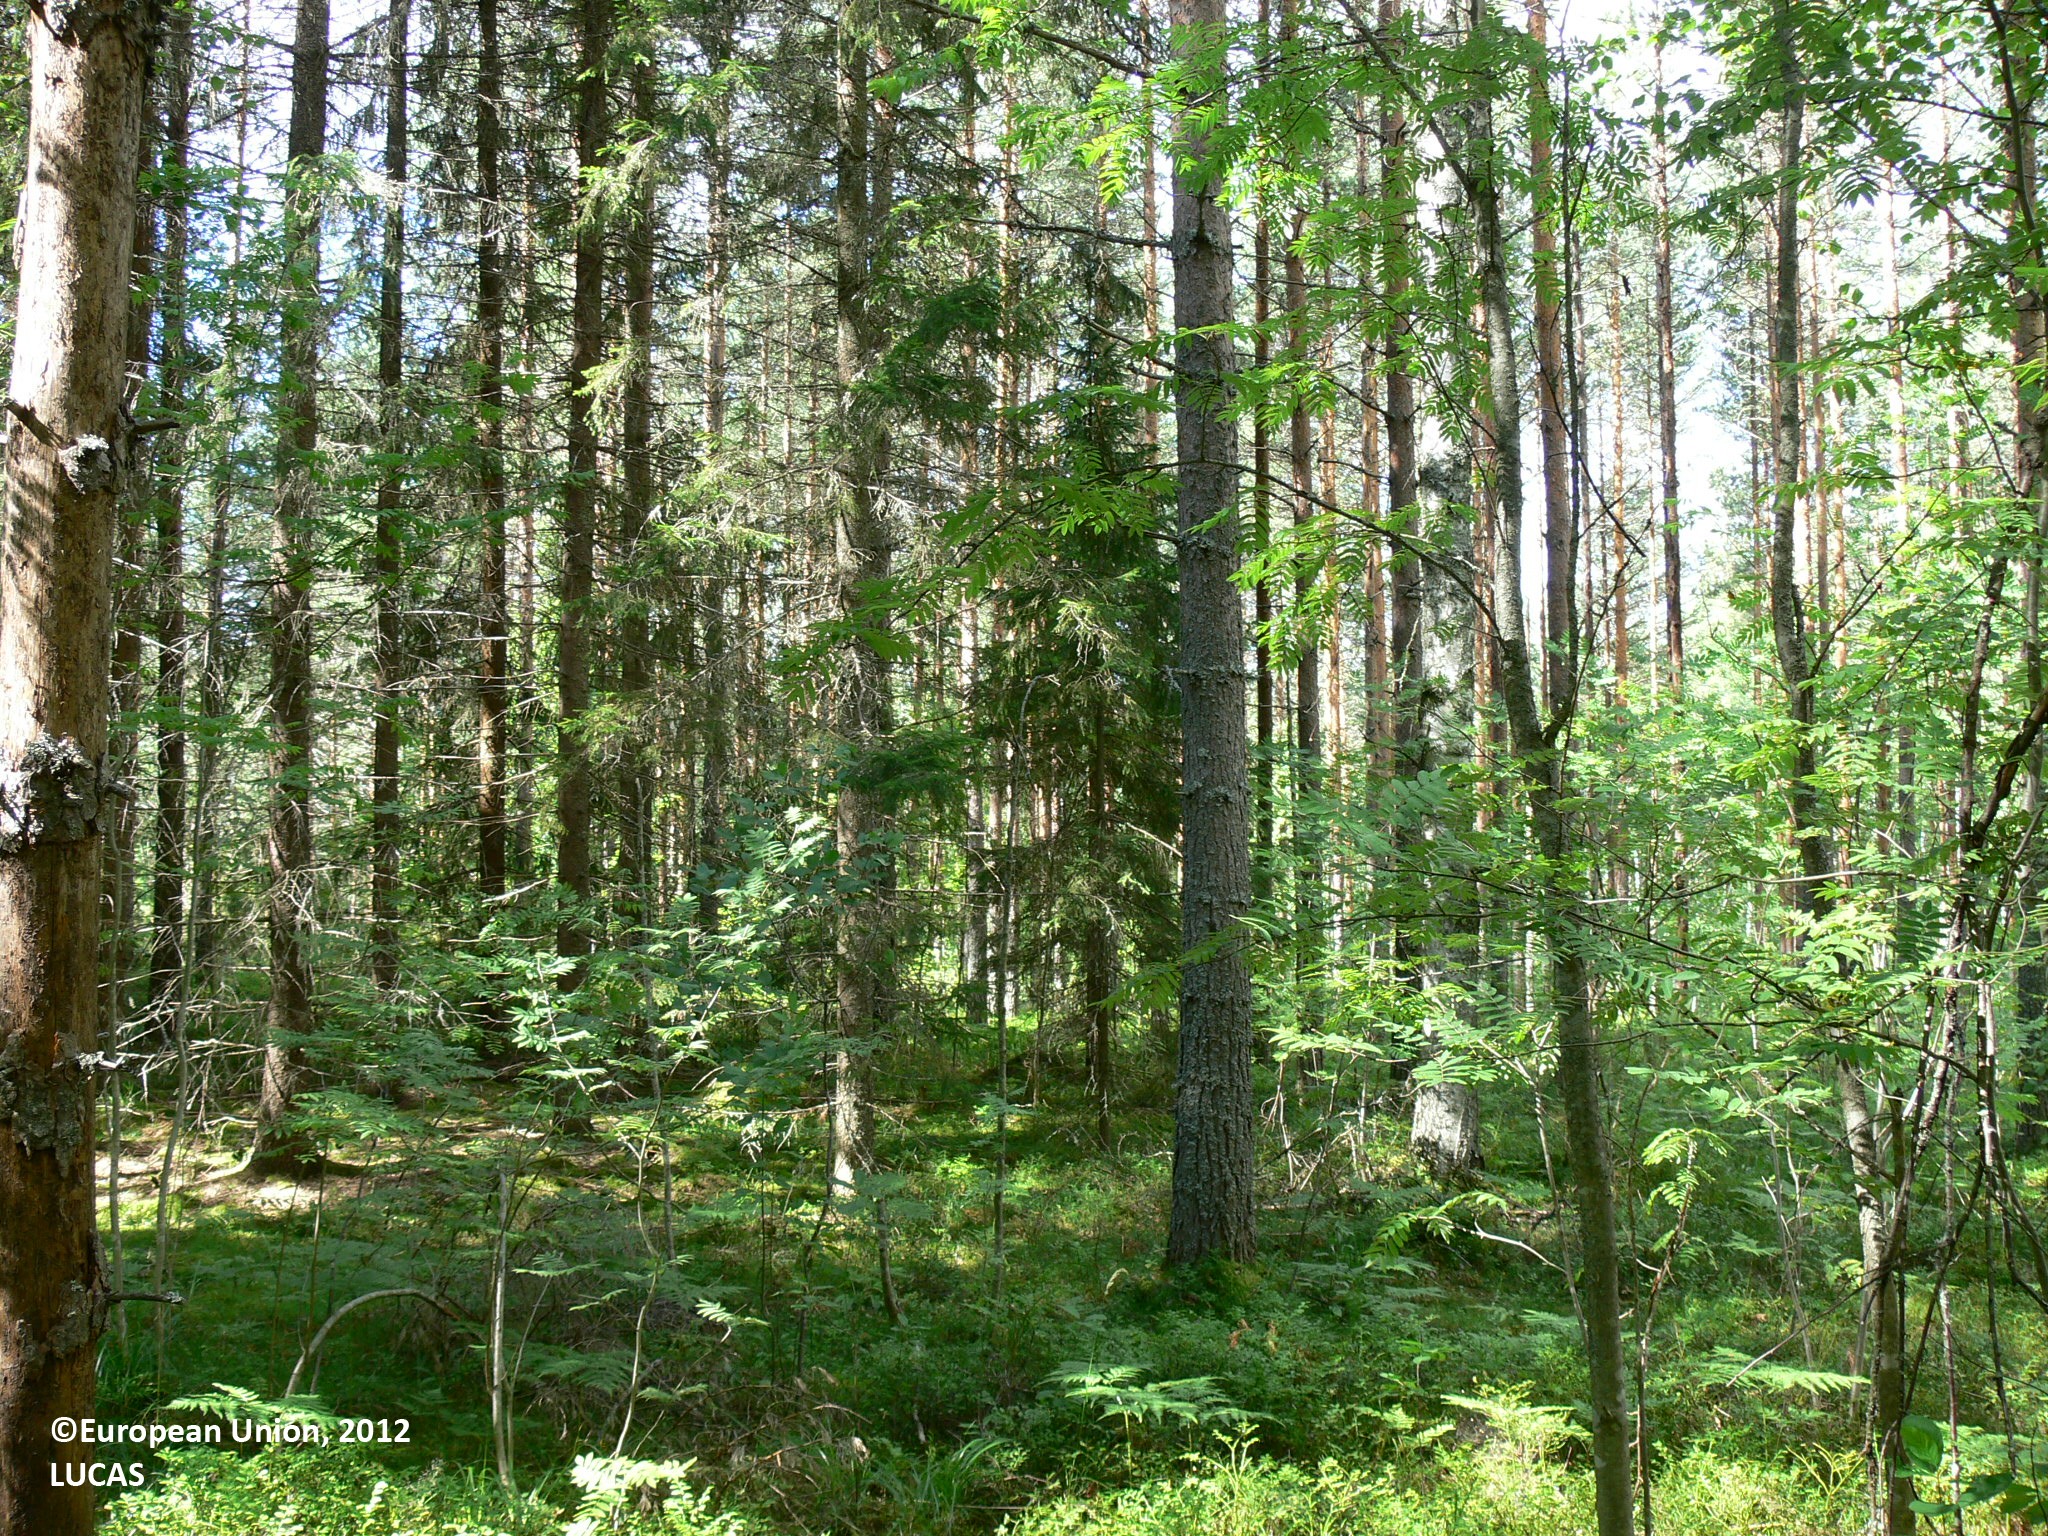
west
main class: Woodland
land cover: Pine dominated mixed woodland
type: boreal forest
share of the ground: > 75 %
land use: Forestry
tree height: > 5 m
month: August
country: FI
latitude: 62.0494
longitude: 29.4636
